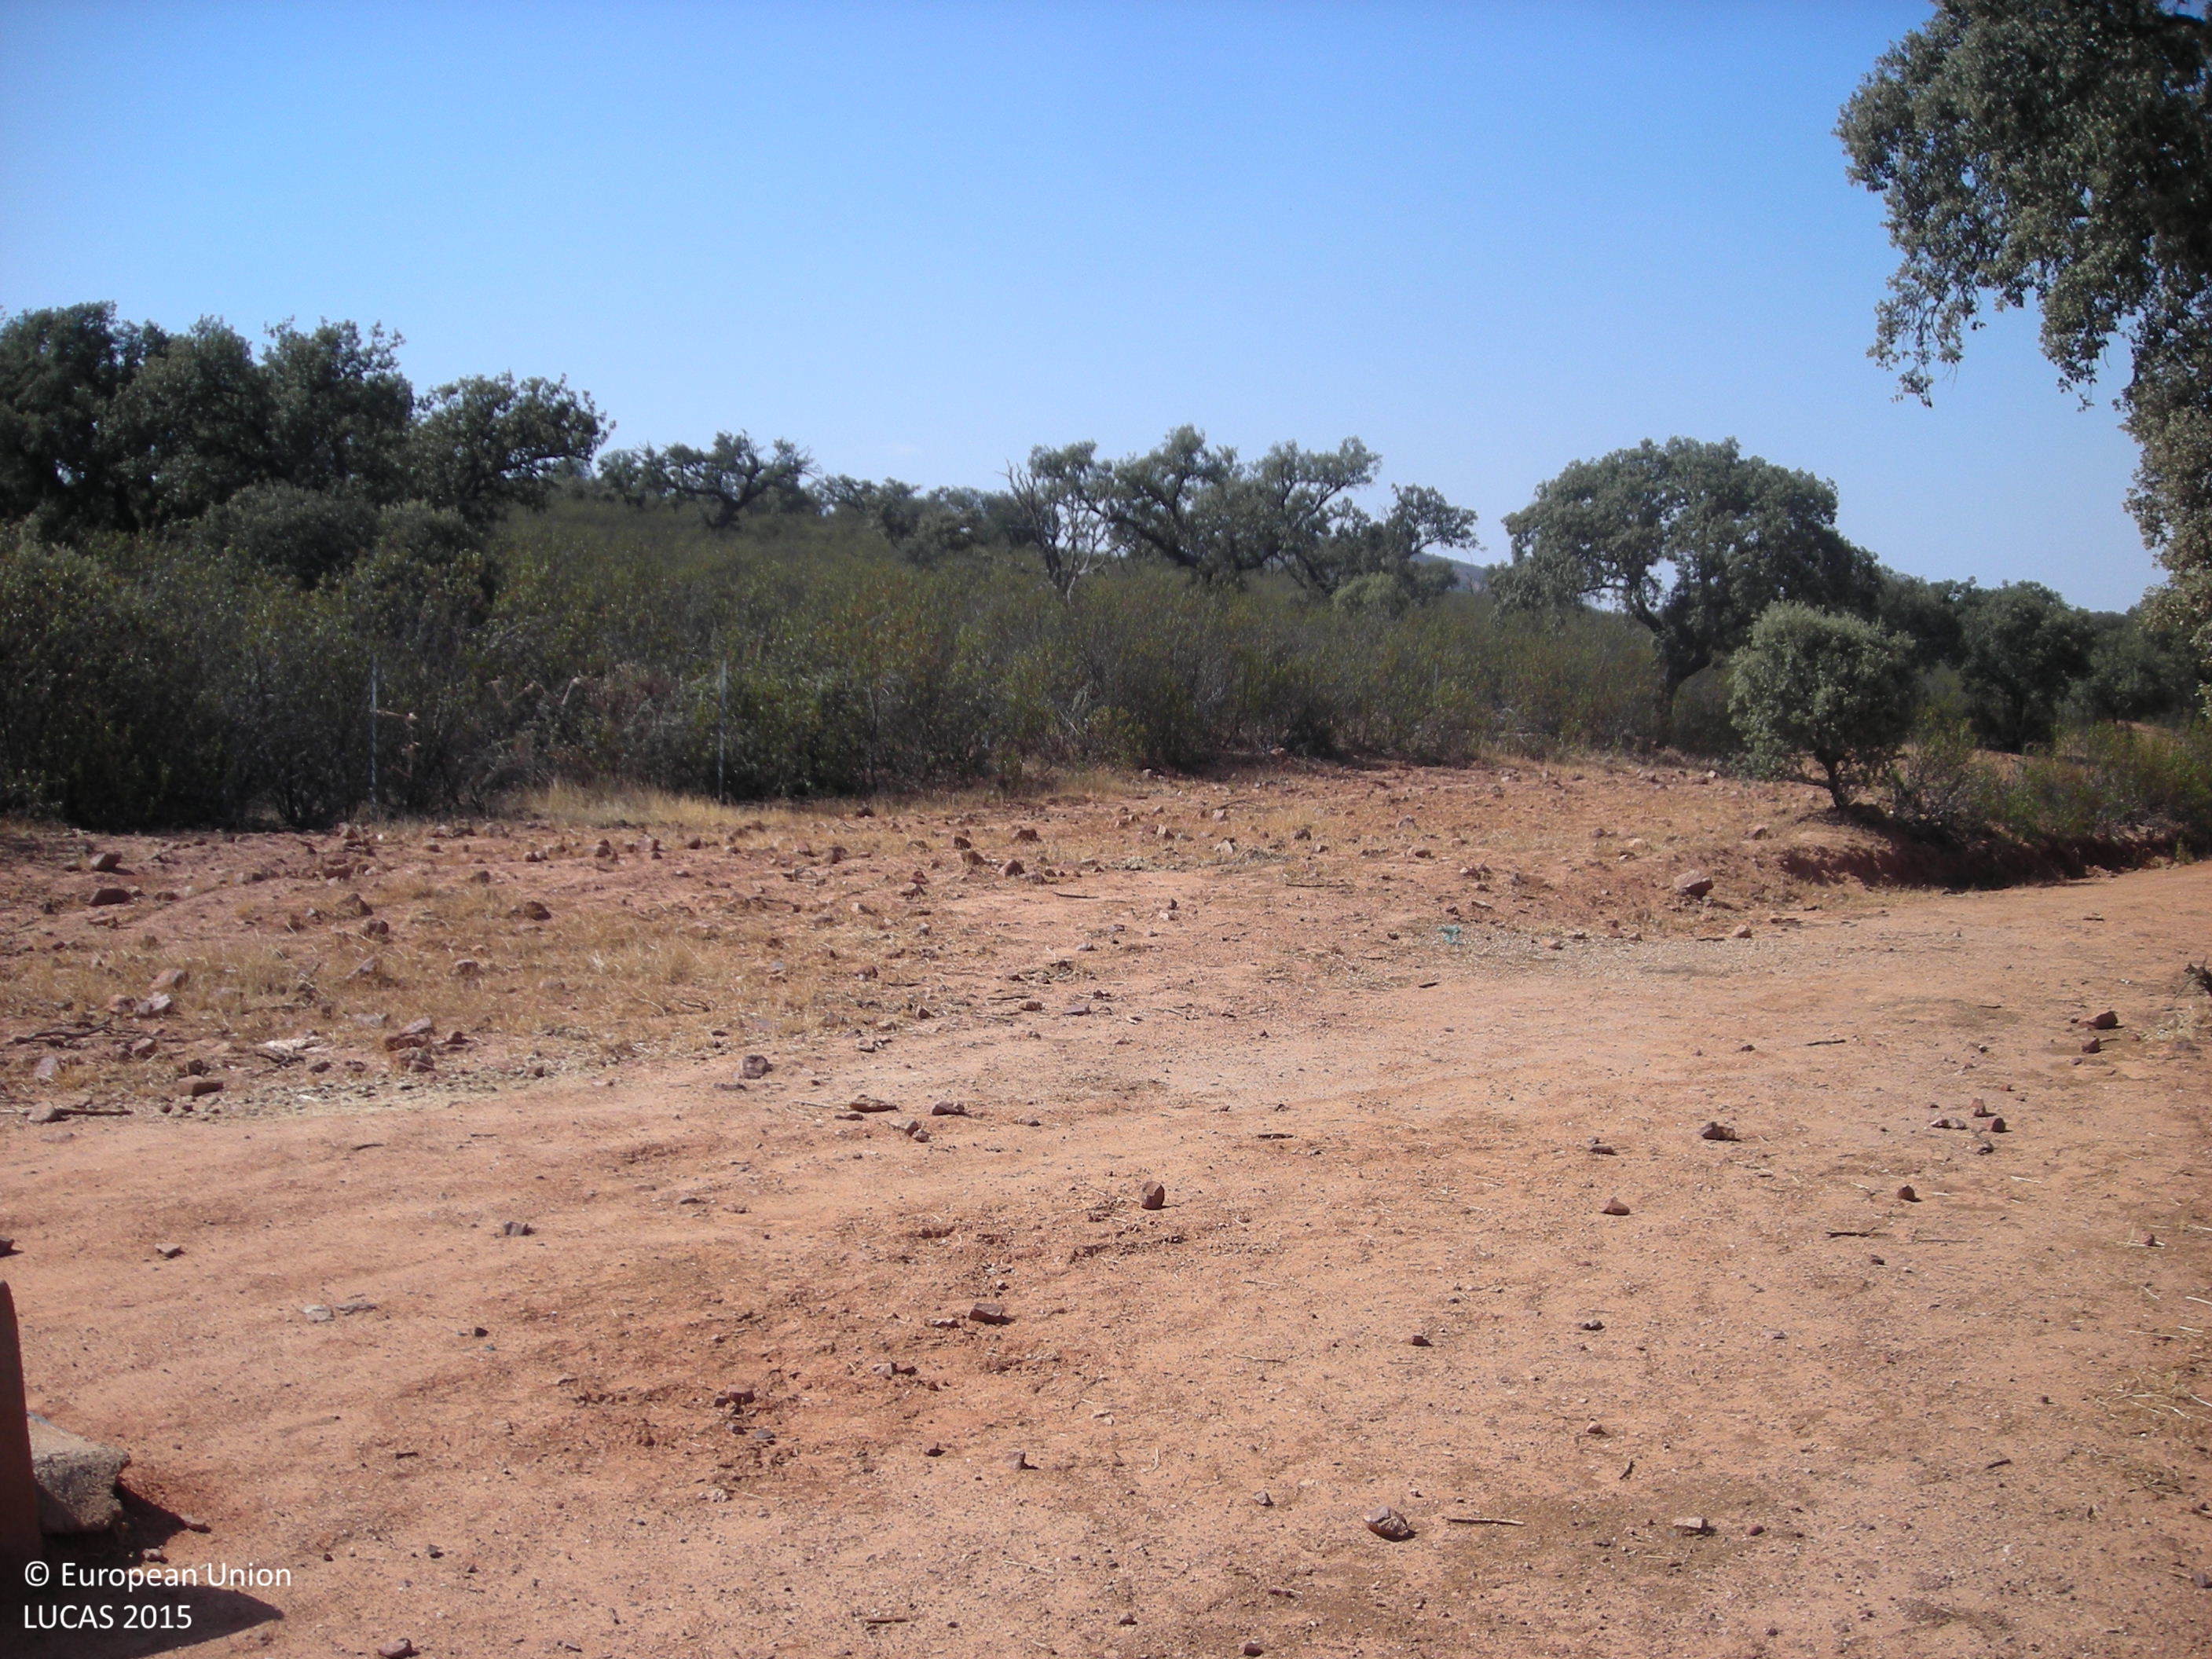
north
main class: Woodland
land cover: Broadleaved woodland
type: broadleaved evergreen forest
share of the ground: 10 - 25 %
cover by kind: unconsolidated bare surface 65 %, herbaceous plants 20 %, broadleaved forest trees 15 %
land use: Forestry
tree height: > 5 m
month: June
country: ES
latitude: 38.6046
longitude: -5.8320
